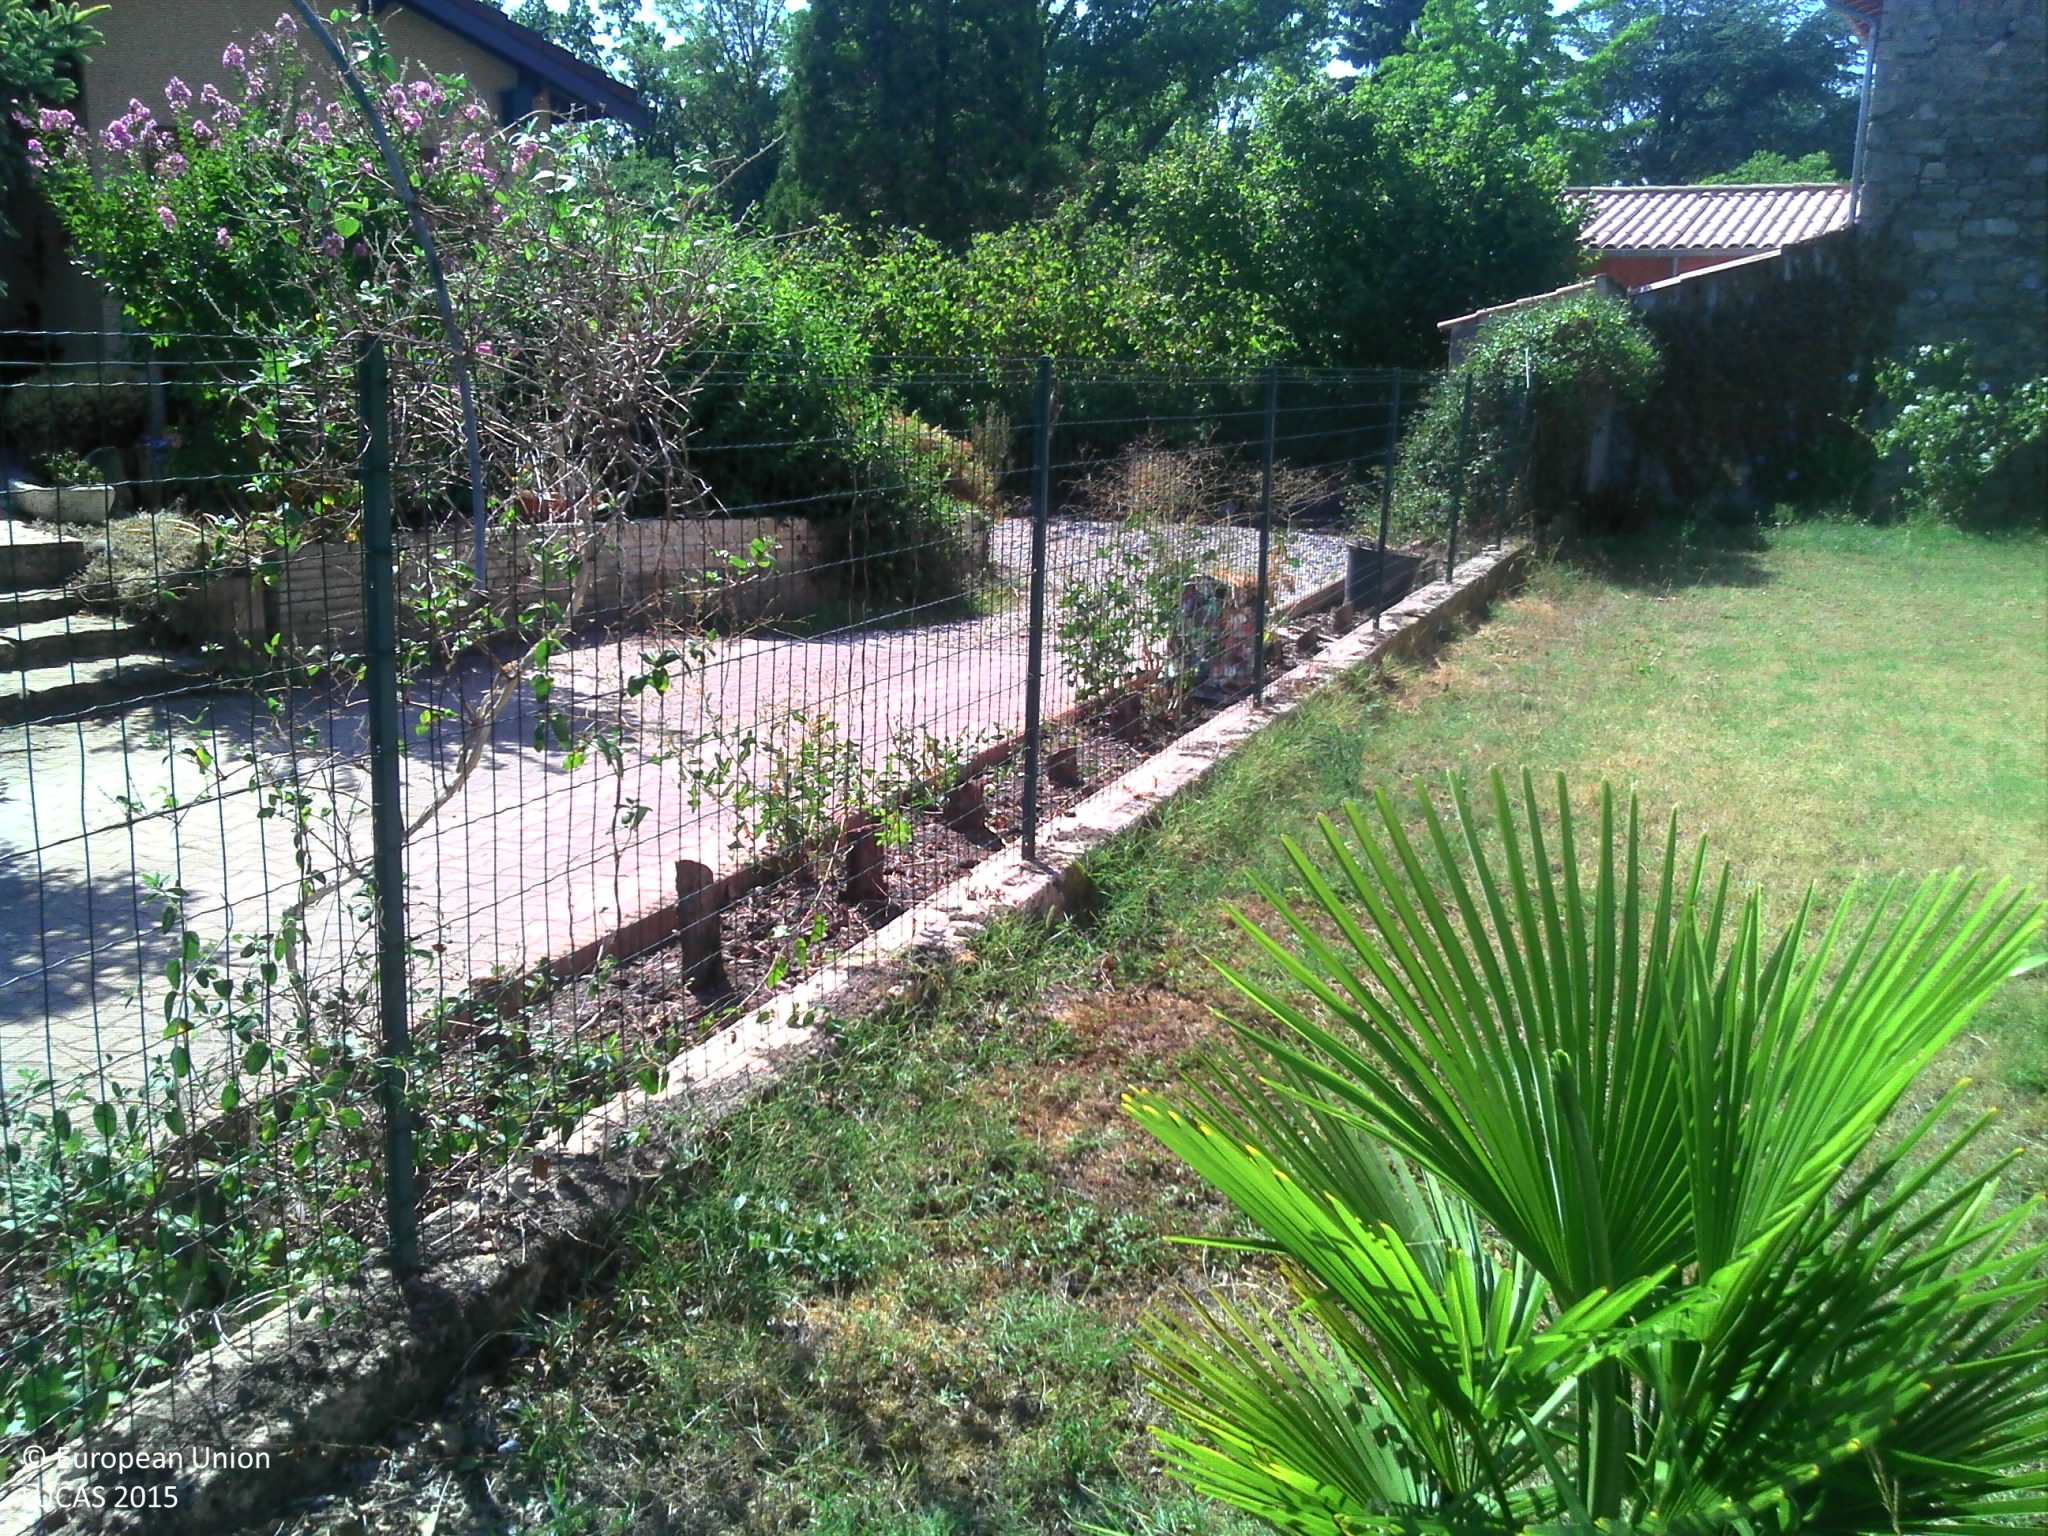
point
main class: Grassland
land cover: Grassland without tree/shrub cover
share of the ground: > 75 %
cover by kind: herbaceous plants 100 %
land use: Residential
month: August
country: FR
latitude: 45.6065
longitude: 4.7084
